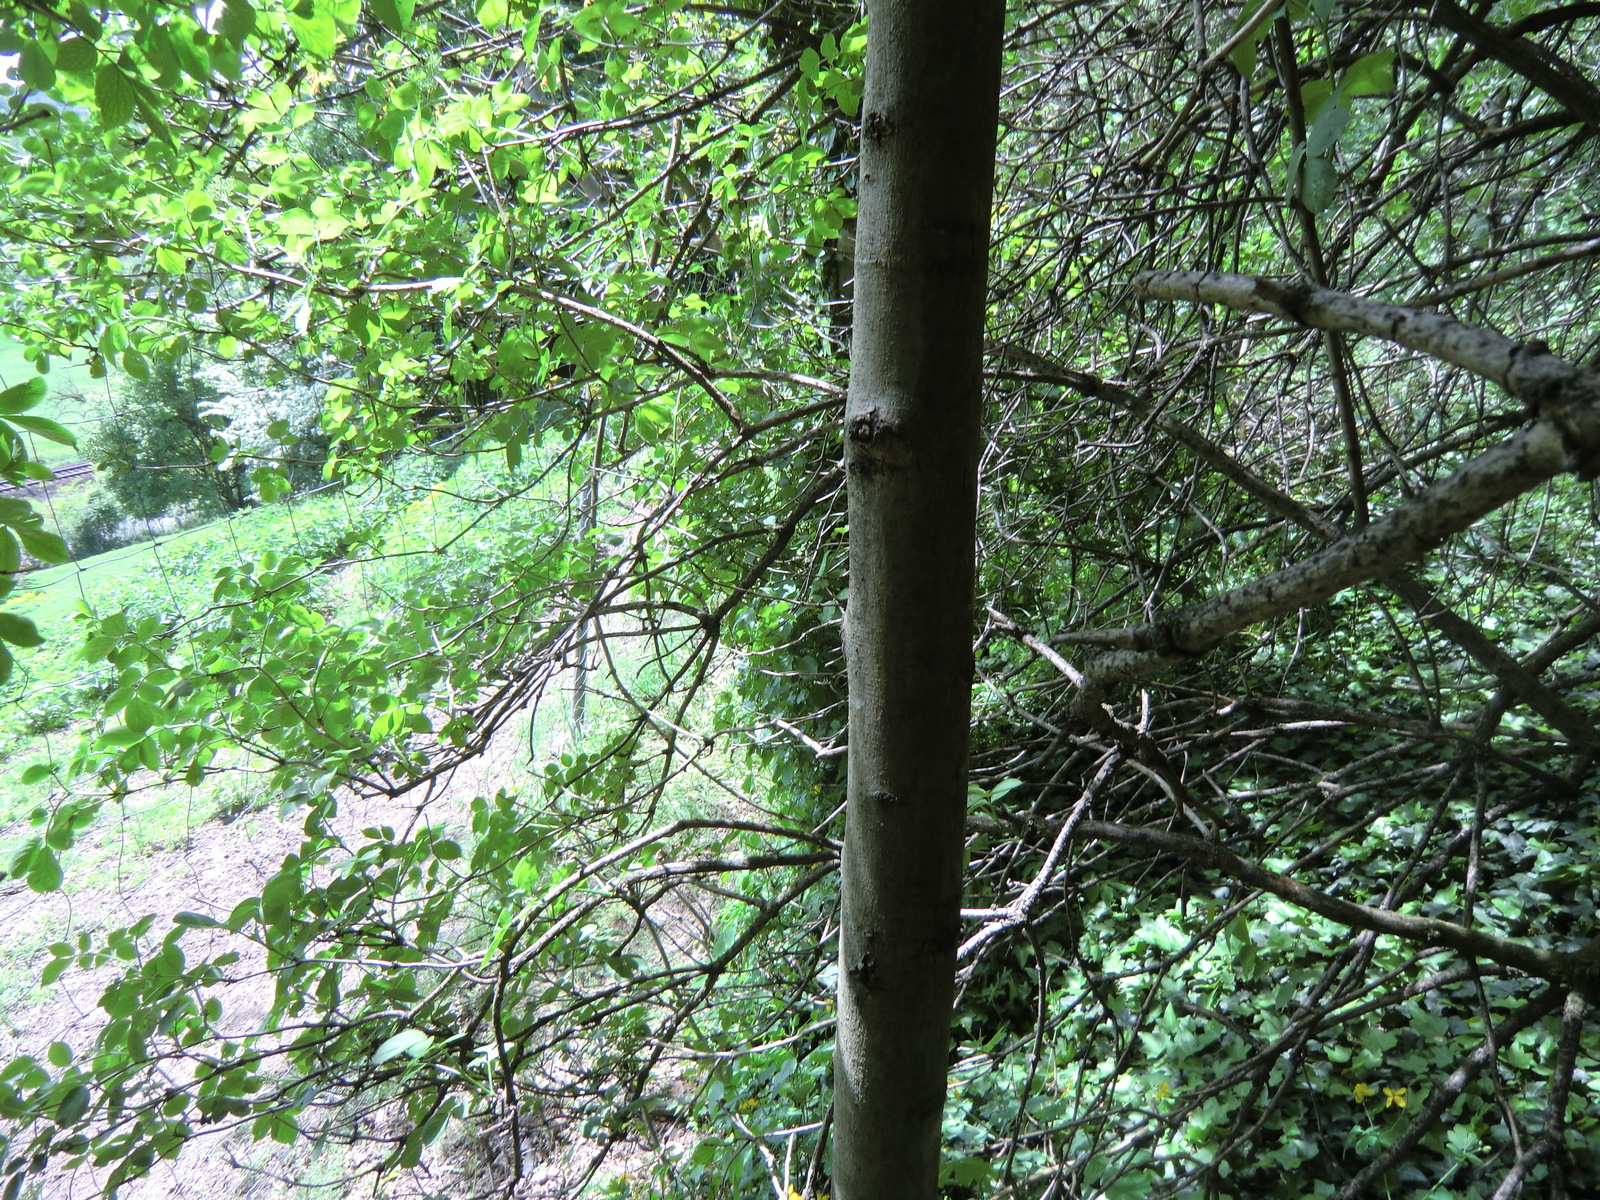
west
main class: Grassland
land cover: Grassland without tree/shrub cover
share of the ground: > 75 %
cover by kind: herbaceous plants 100 %
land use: Agriculture (excluding fallow land and kitchen gardens)
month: May
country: AT
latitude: 48.2807
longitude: 14.3798
